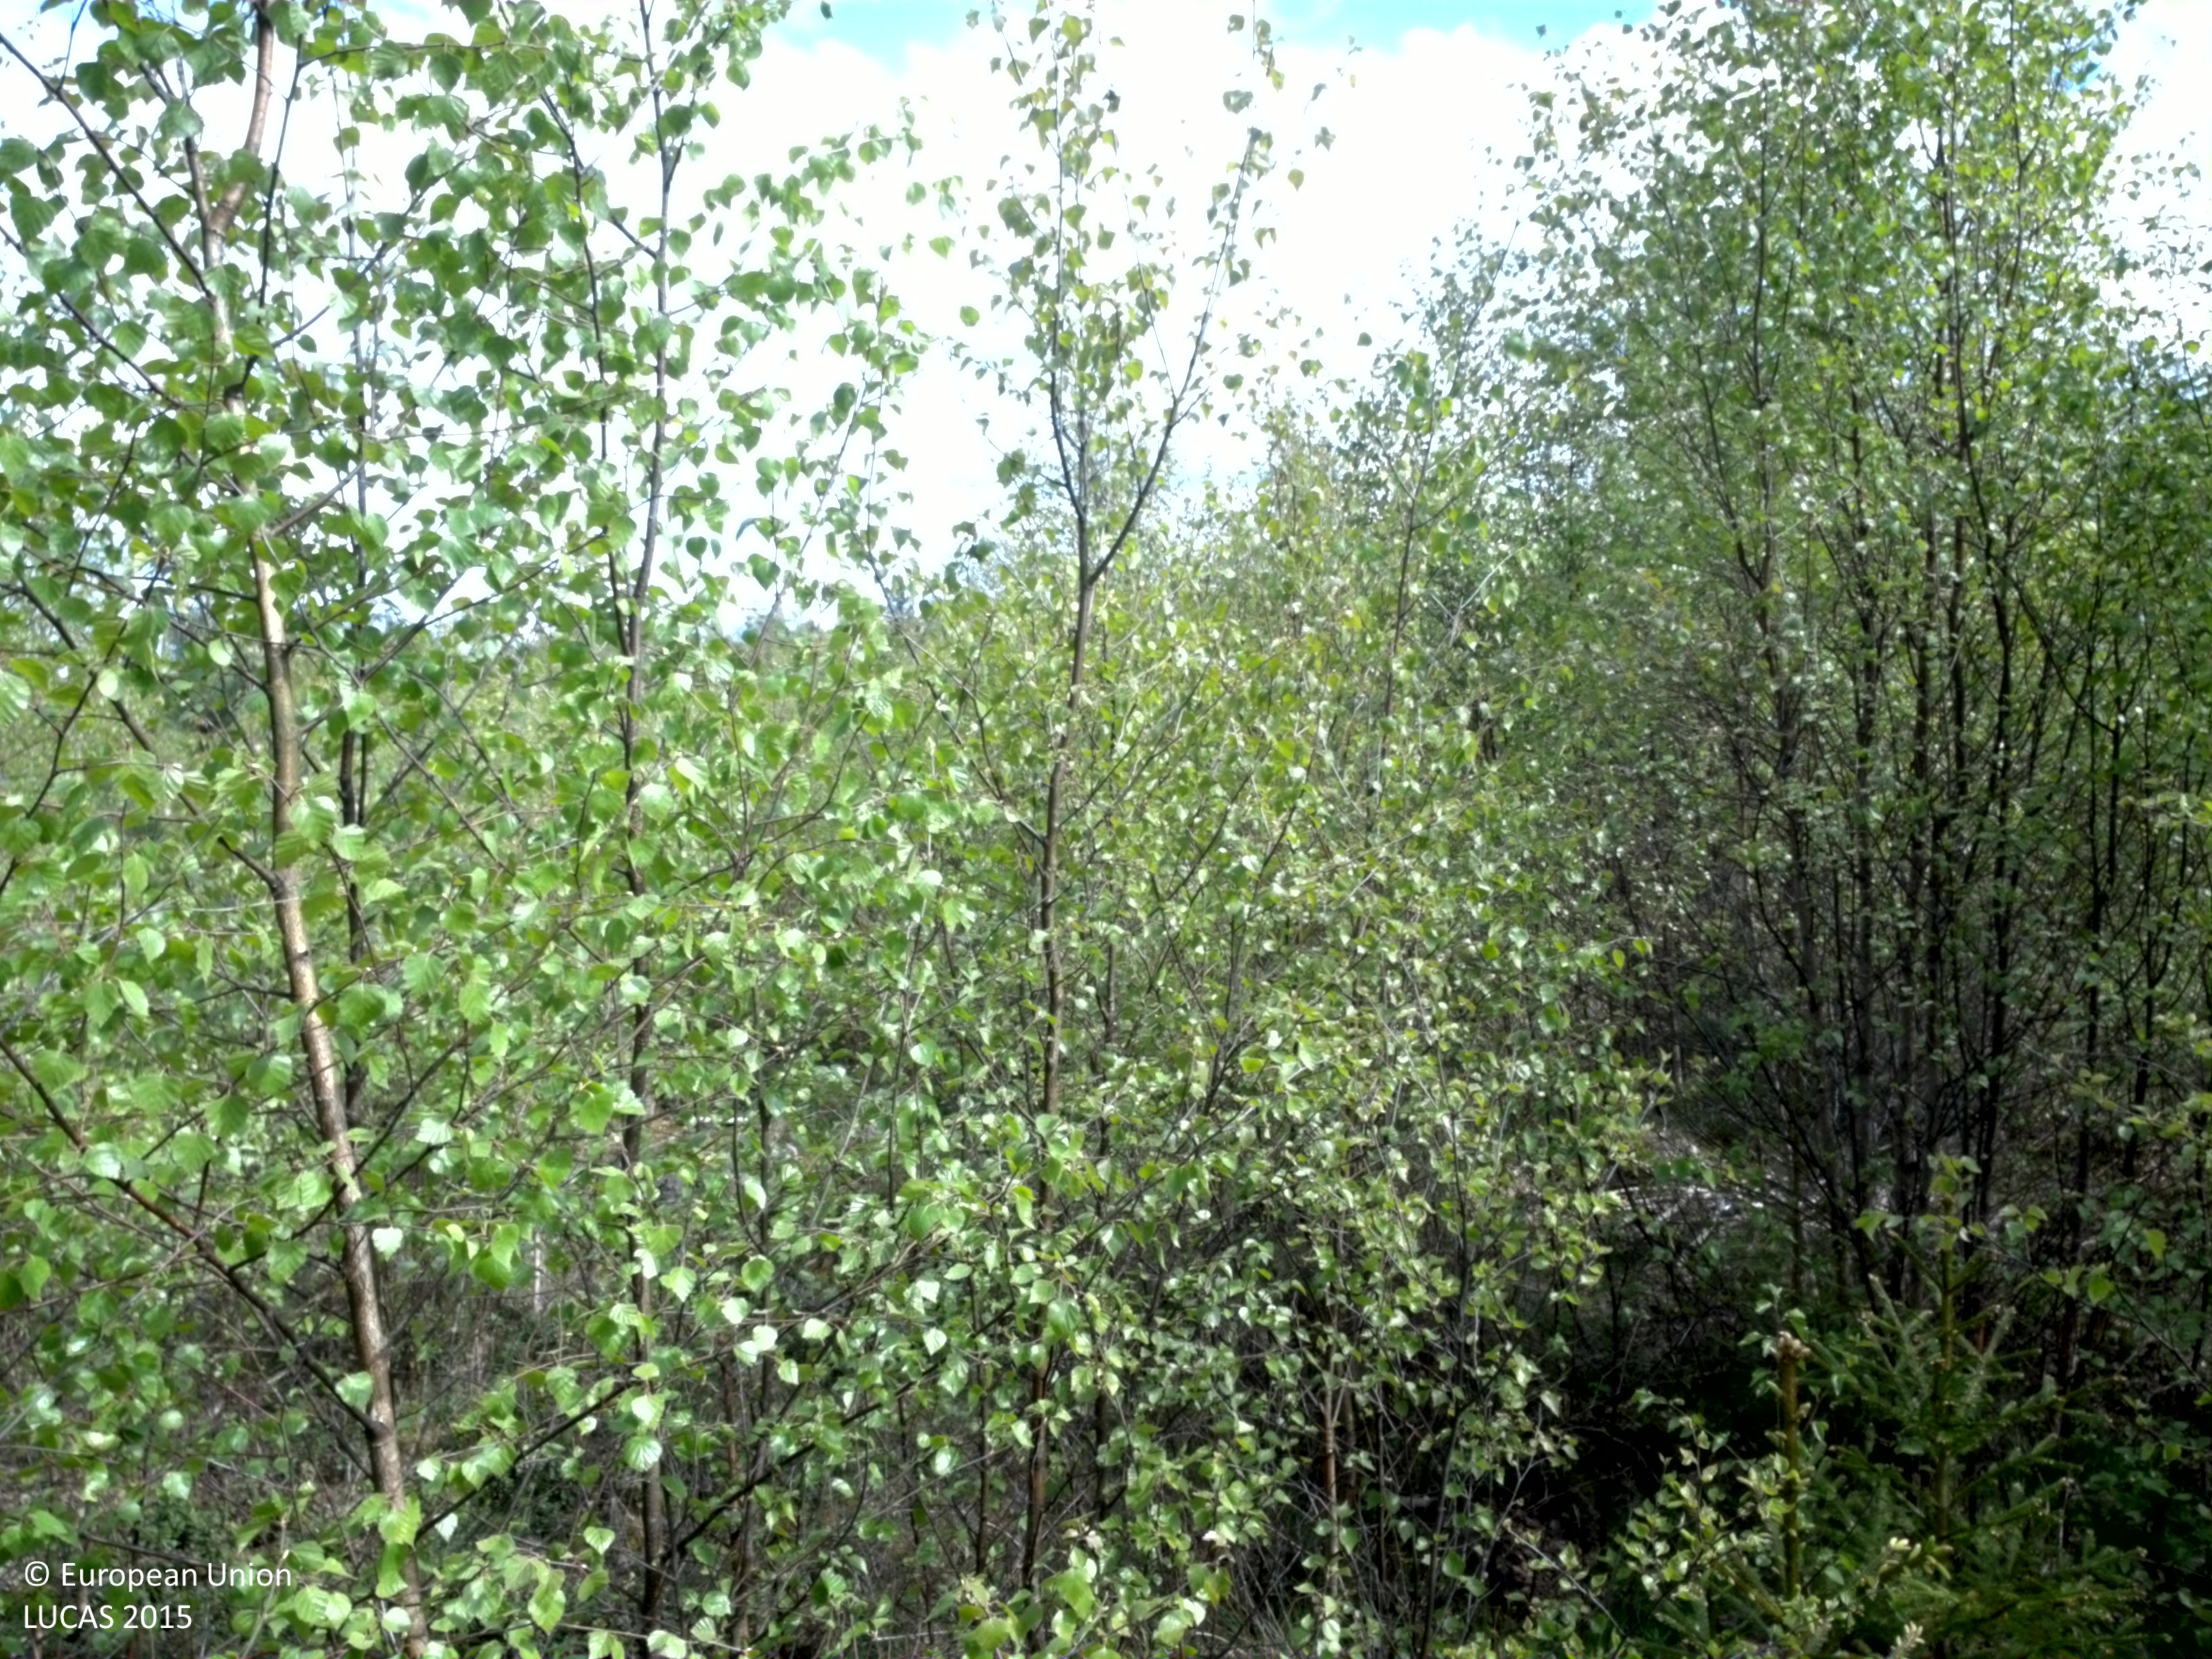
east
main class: Woodland
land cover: Broadleaved woodland
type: boreal forest
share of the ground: > 75 %
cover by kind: broadleaved forest trees 80 %, coniferous forest trees 10 %, lichens and mosses 10 %
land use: Forestry
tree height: < 5 m
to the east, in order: Broadleaved woodland; Spruce dominated mixed woodland; Broadleaved woodland; Ditches and canals; Broadleaved woodland; Spruce dominated mixed woodland
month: May
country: SE
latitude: 56.6868
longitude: 14.4540
